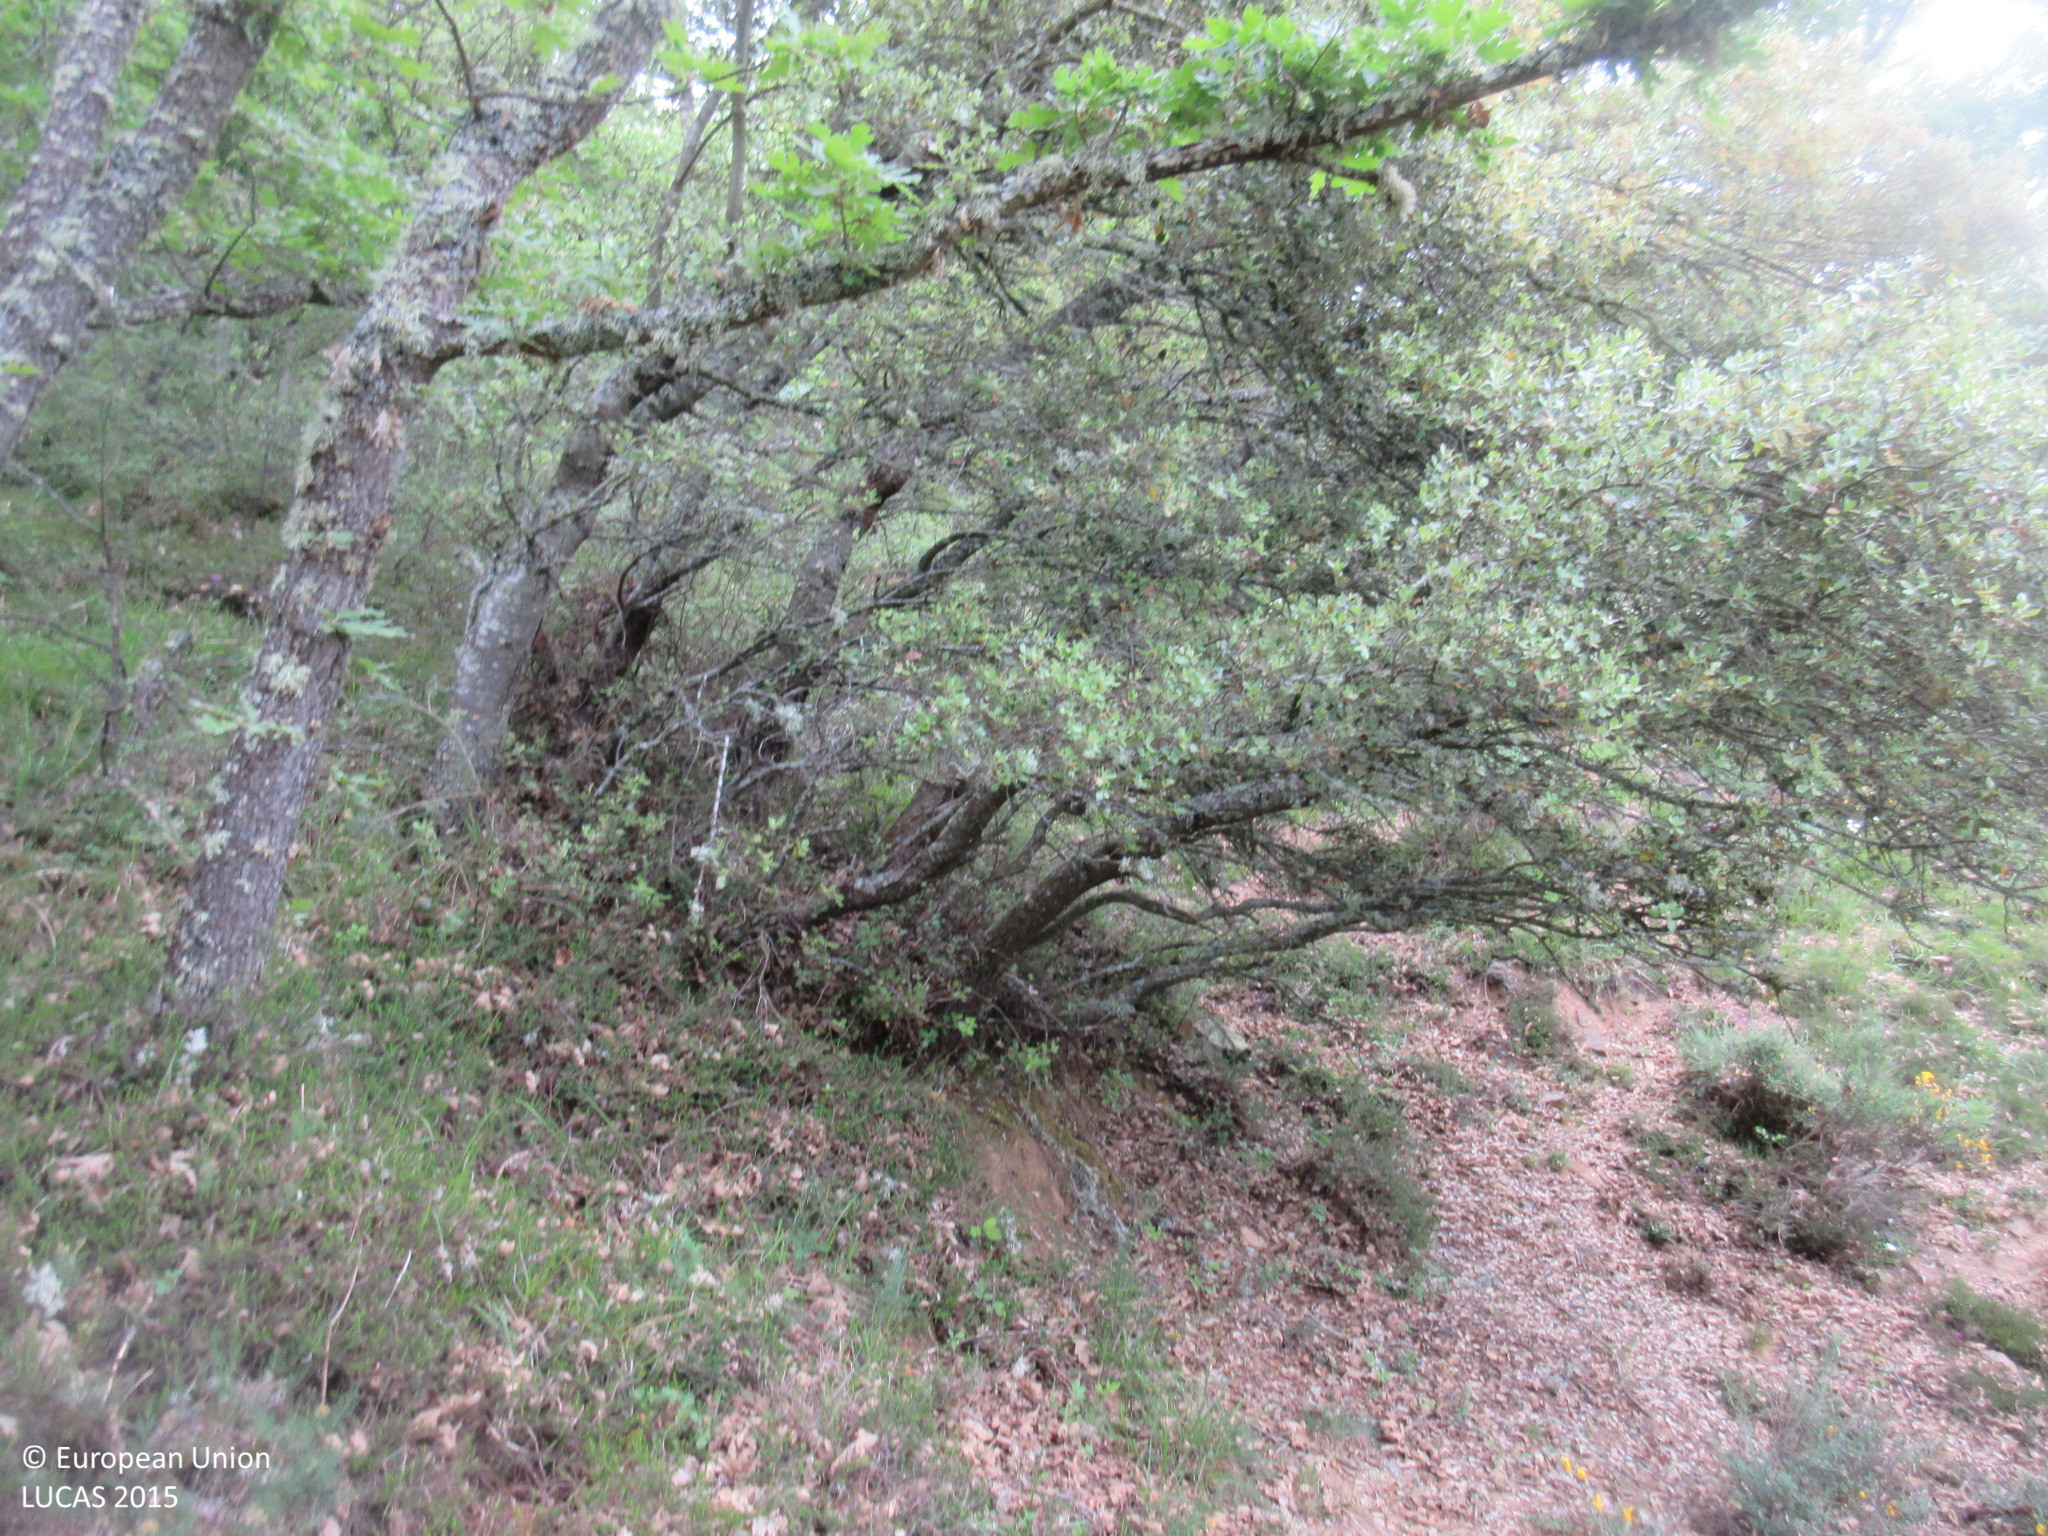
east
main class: Woodland
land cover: Broadleaved woodland
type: acidophilous oak and oak-birch forest
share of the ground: > 75 %
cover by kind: broadleaved forest trees 90 %, shrubs 10 %
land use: Forestry
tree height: > 5 m
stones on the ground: 10 - 25 %
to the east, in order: Broadleaved woodland; Fences; Grassland with sparse tree/shrub cover; Broadleaved woodland
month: June
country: ES
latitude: 43.0997
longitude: -4.5442
